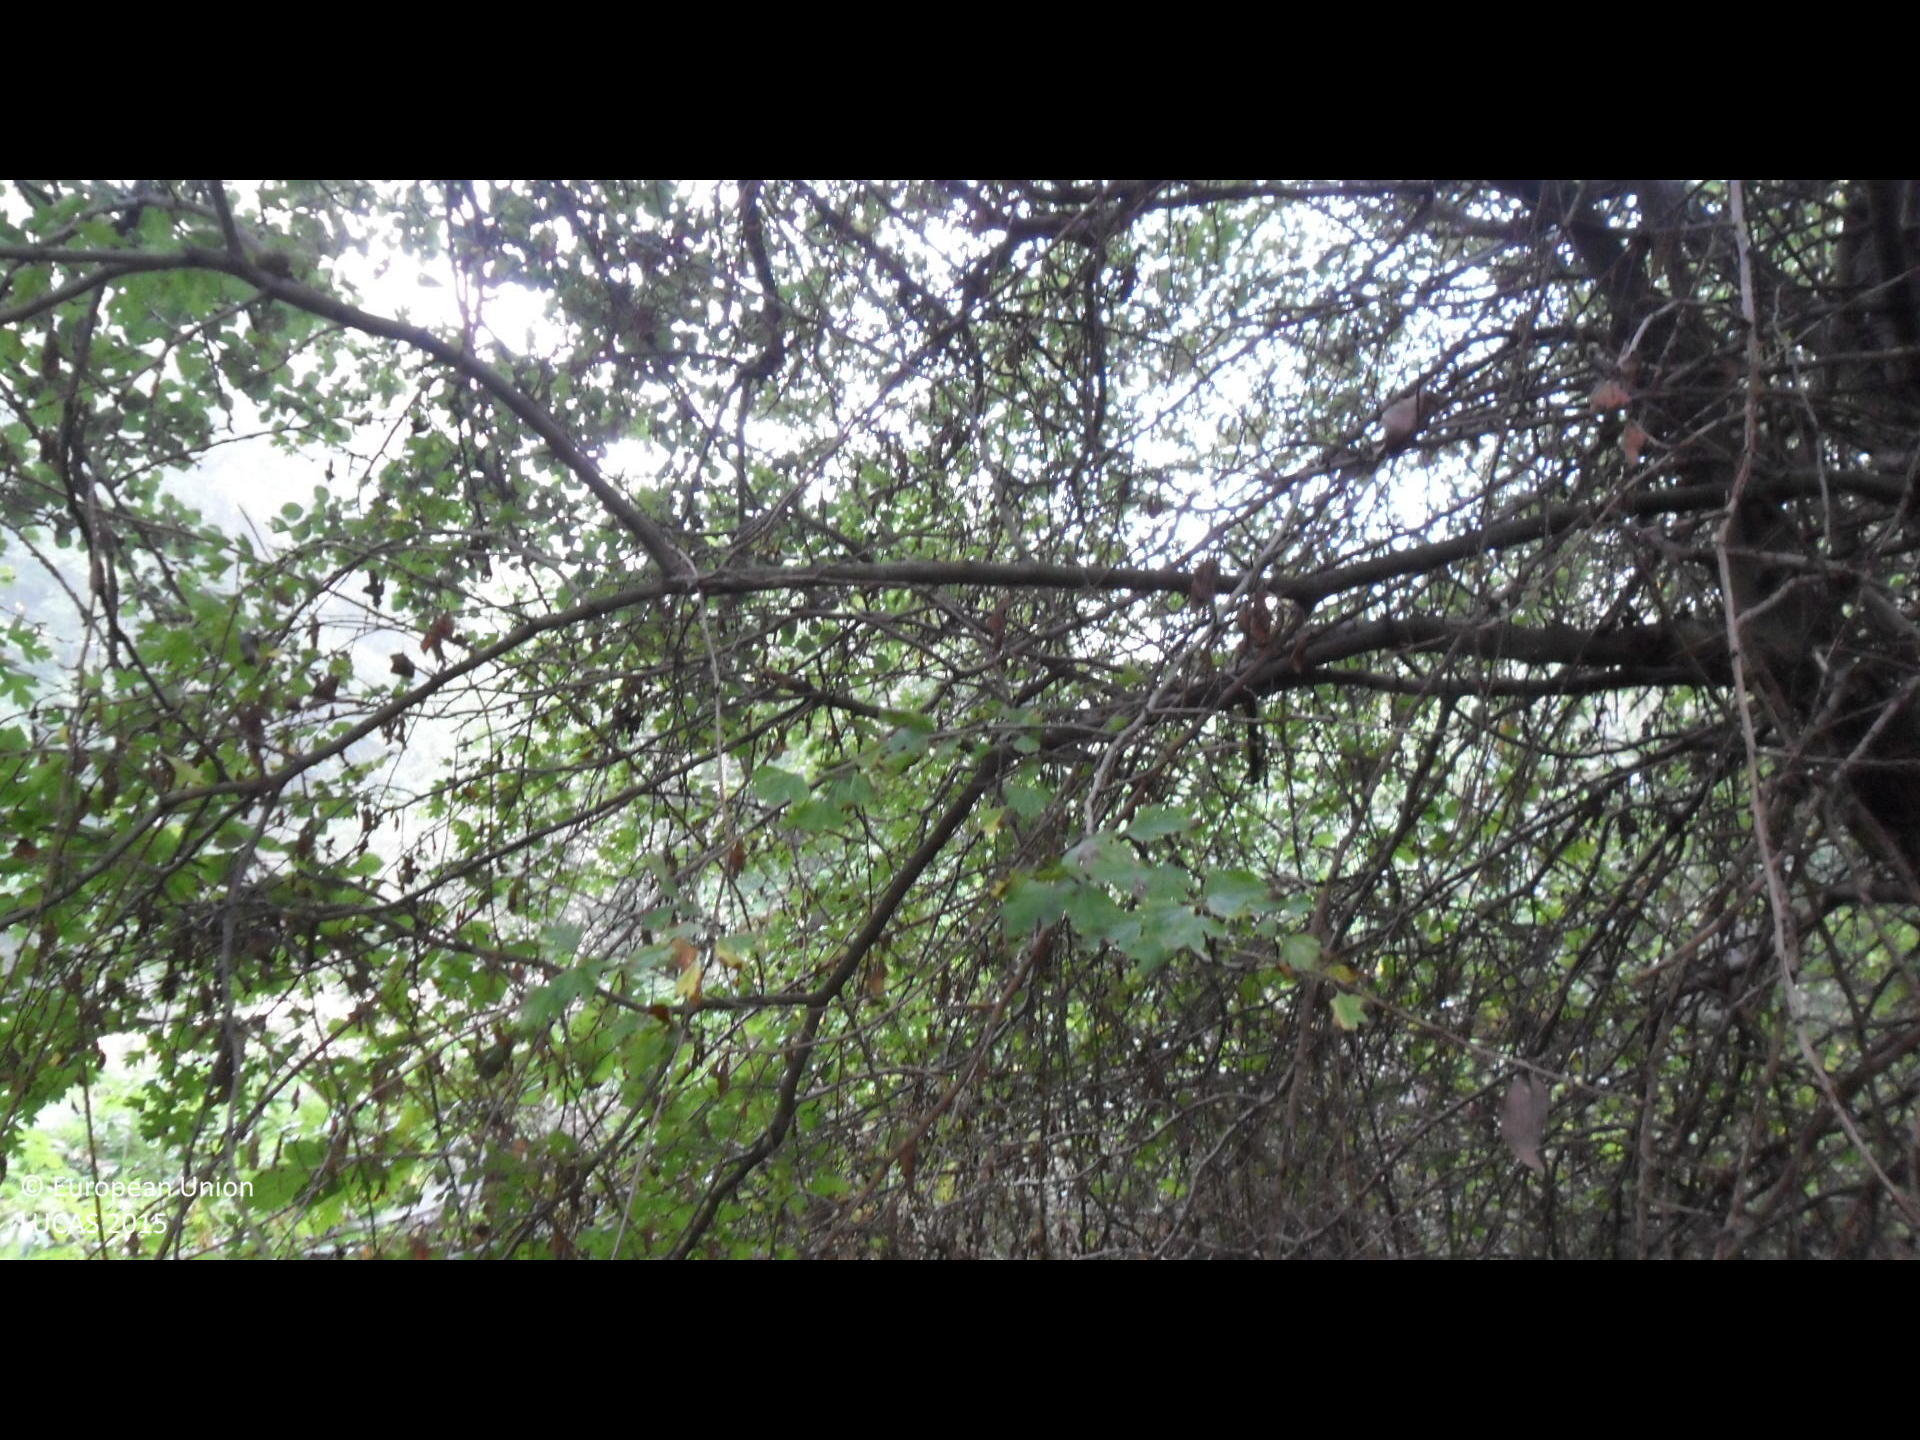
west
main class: Woodland
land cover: Broadleaved woodland
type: mesophytic deciduous forest
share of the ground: > 75 %
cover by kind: broadleaved forest trees 95 %, unconsolidated bare surface 5 %
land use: Agriculture (excluding fallow land and kitchen gardens)
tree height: > 5 m
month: September
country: BG
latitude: 43.0999
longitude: 26.4522
